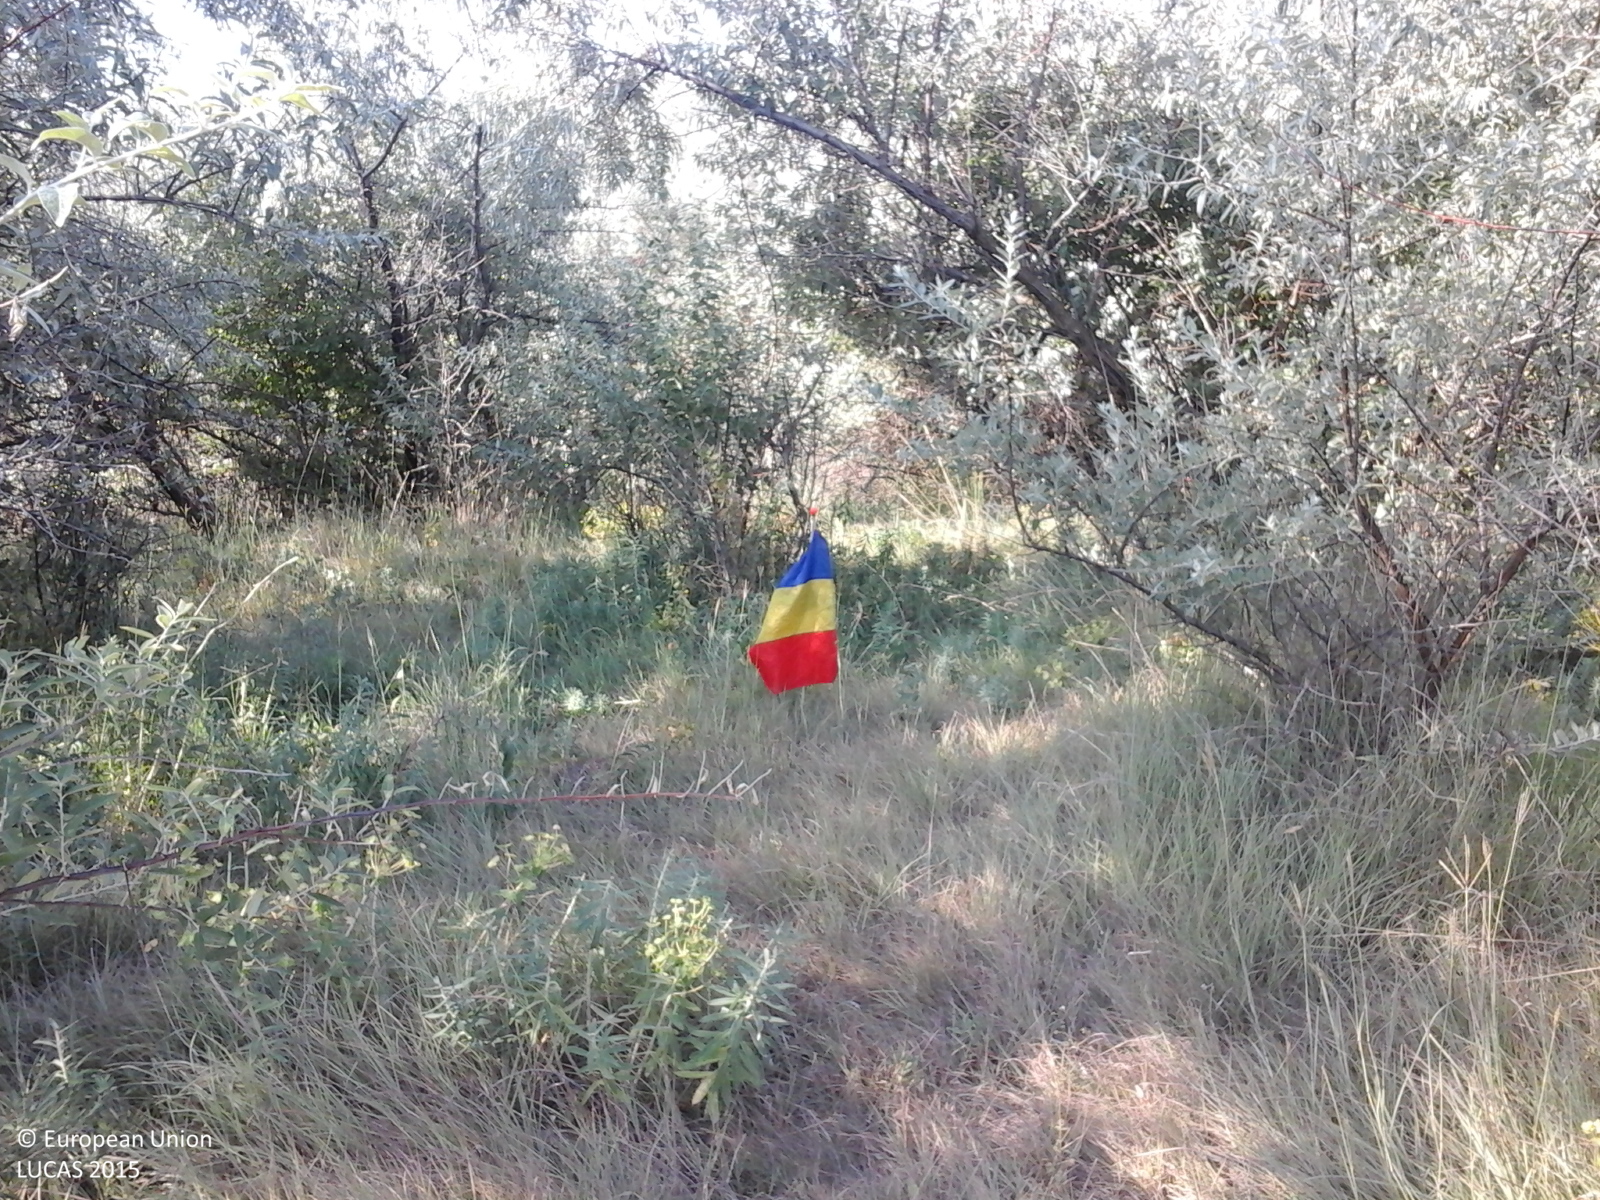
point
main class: Shrubland
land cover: Shrubland without tree cover
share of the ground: > 75 %
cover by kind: shrubs 70 %, herbaceous plants 30 %
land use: Agriculture (excluding fallow land and kitchen gardens)
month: July
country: RO
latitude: 46.5313
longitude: 28.1632
